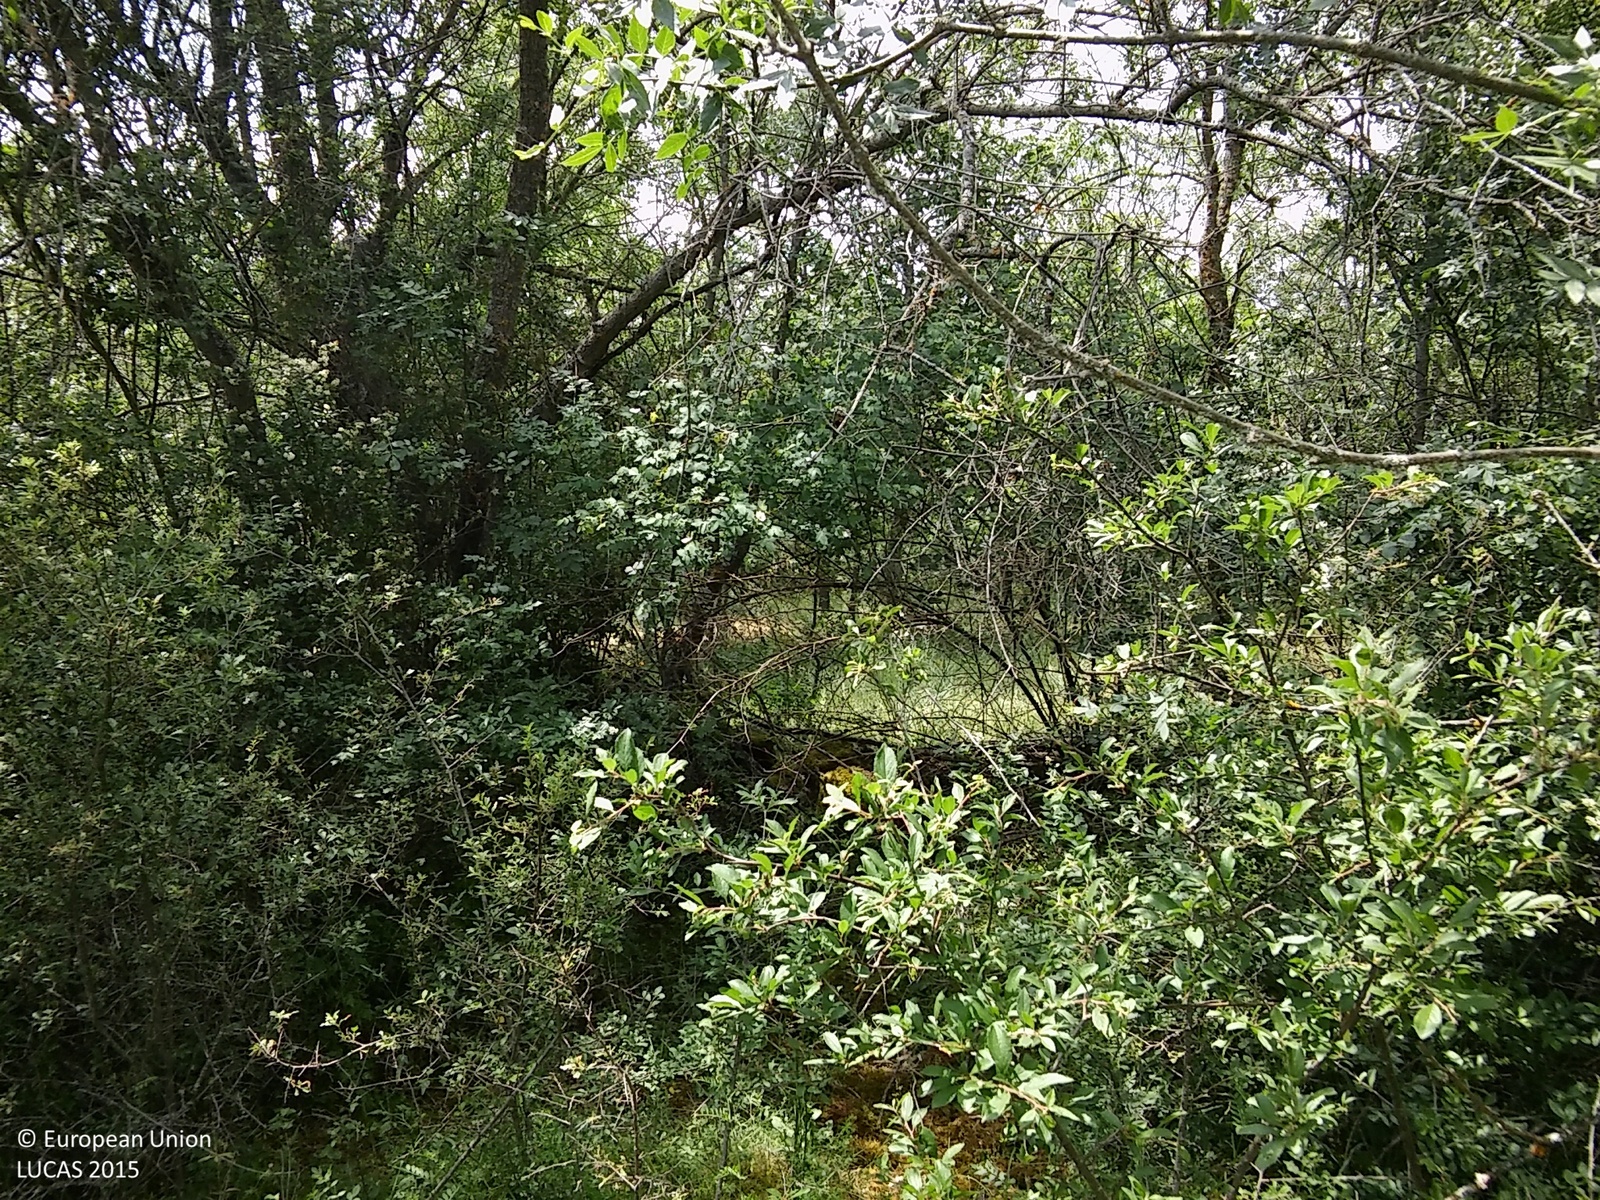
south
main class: Woodland
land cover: Broadleaved woodland
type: non-riverine alder, birch or aspen forest
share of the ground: 25 - 50 %
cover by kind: herbaceous plants 60 %, broadleaved forest trees 25 %, shrubs 15 %
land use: Abandoned areas
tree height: > 5 m
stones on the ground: < 10 %
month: June
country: ES
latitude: 41.1490
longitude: -3.7138
